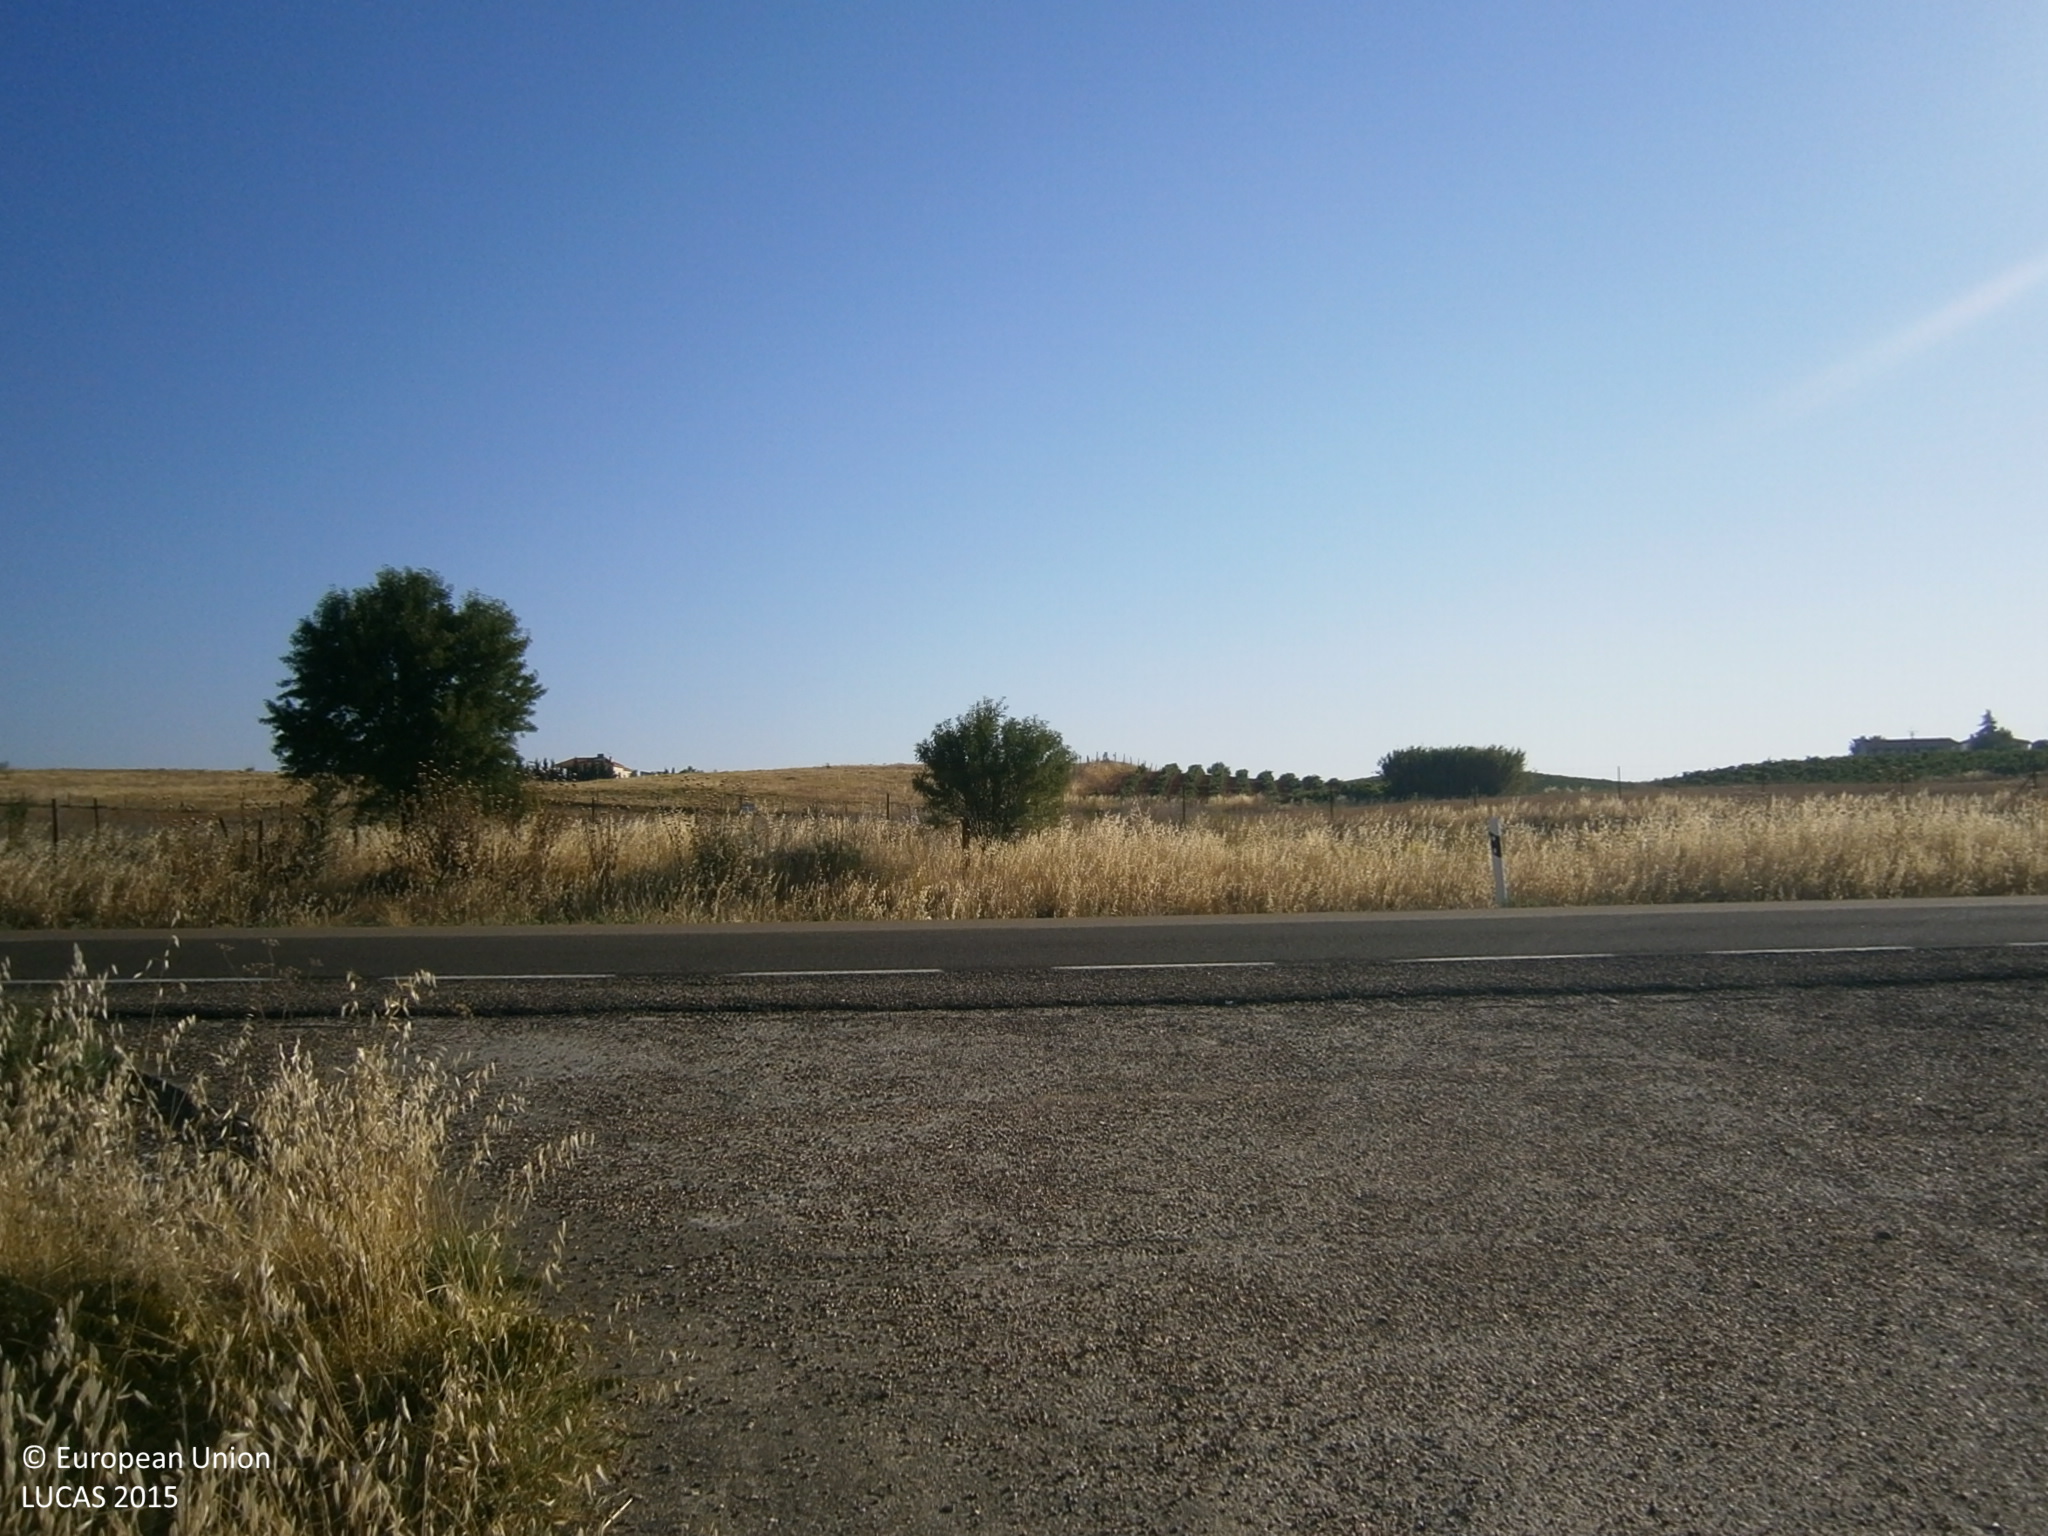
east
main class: Cropland
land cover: Oats
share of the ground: > 75 %
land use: Agriculture (excluding fallow land and kitchen gardens)
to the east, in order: Oats; Rivers and streams; Barley
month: June
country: ES
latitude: 38.8092
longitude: -6.8915
